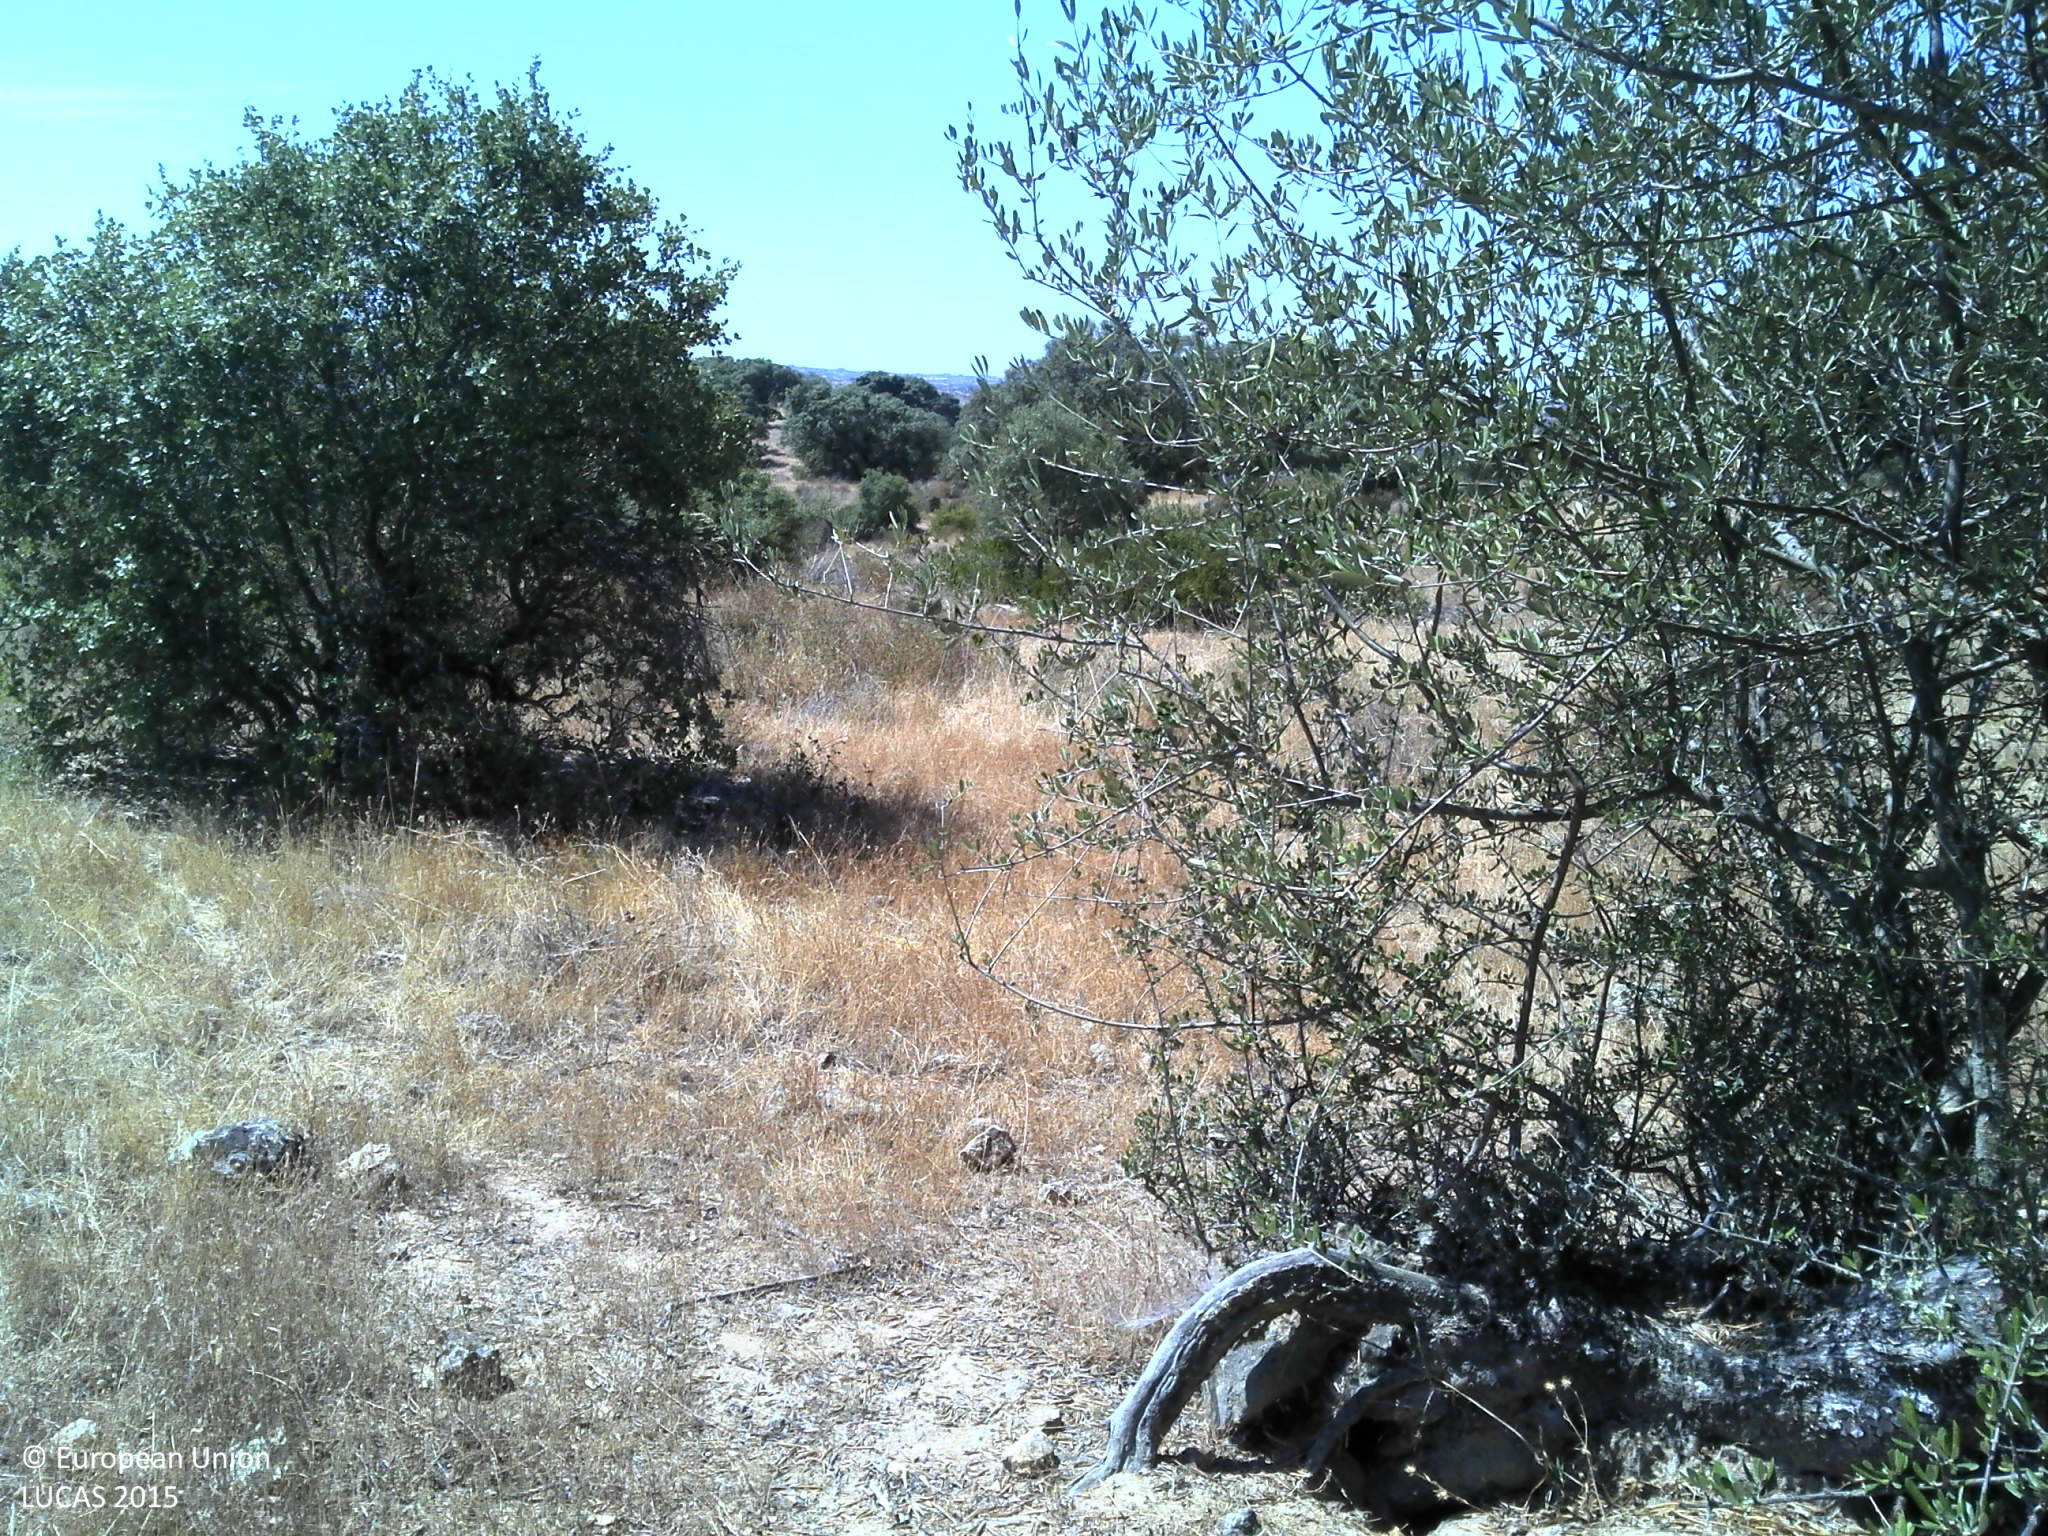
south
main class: Woodland
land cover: Broadleaved woodland
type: broadleaved evergreen forest
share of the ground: 25 - 50 %
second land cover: Grassland without tree/shrub cover
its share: 25 - 50 %
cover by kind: broadleaved forest trees 45 %, herbaceous plants 45 %, unconsolidated bare surface 10 %
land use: Forestry
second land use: Agriculture (excluding fallow land and kitchen gardens)
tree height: < 5 m
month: June
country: PT
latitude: 37.9051
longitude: -7.4980
